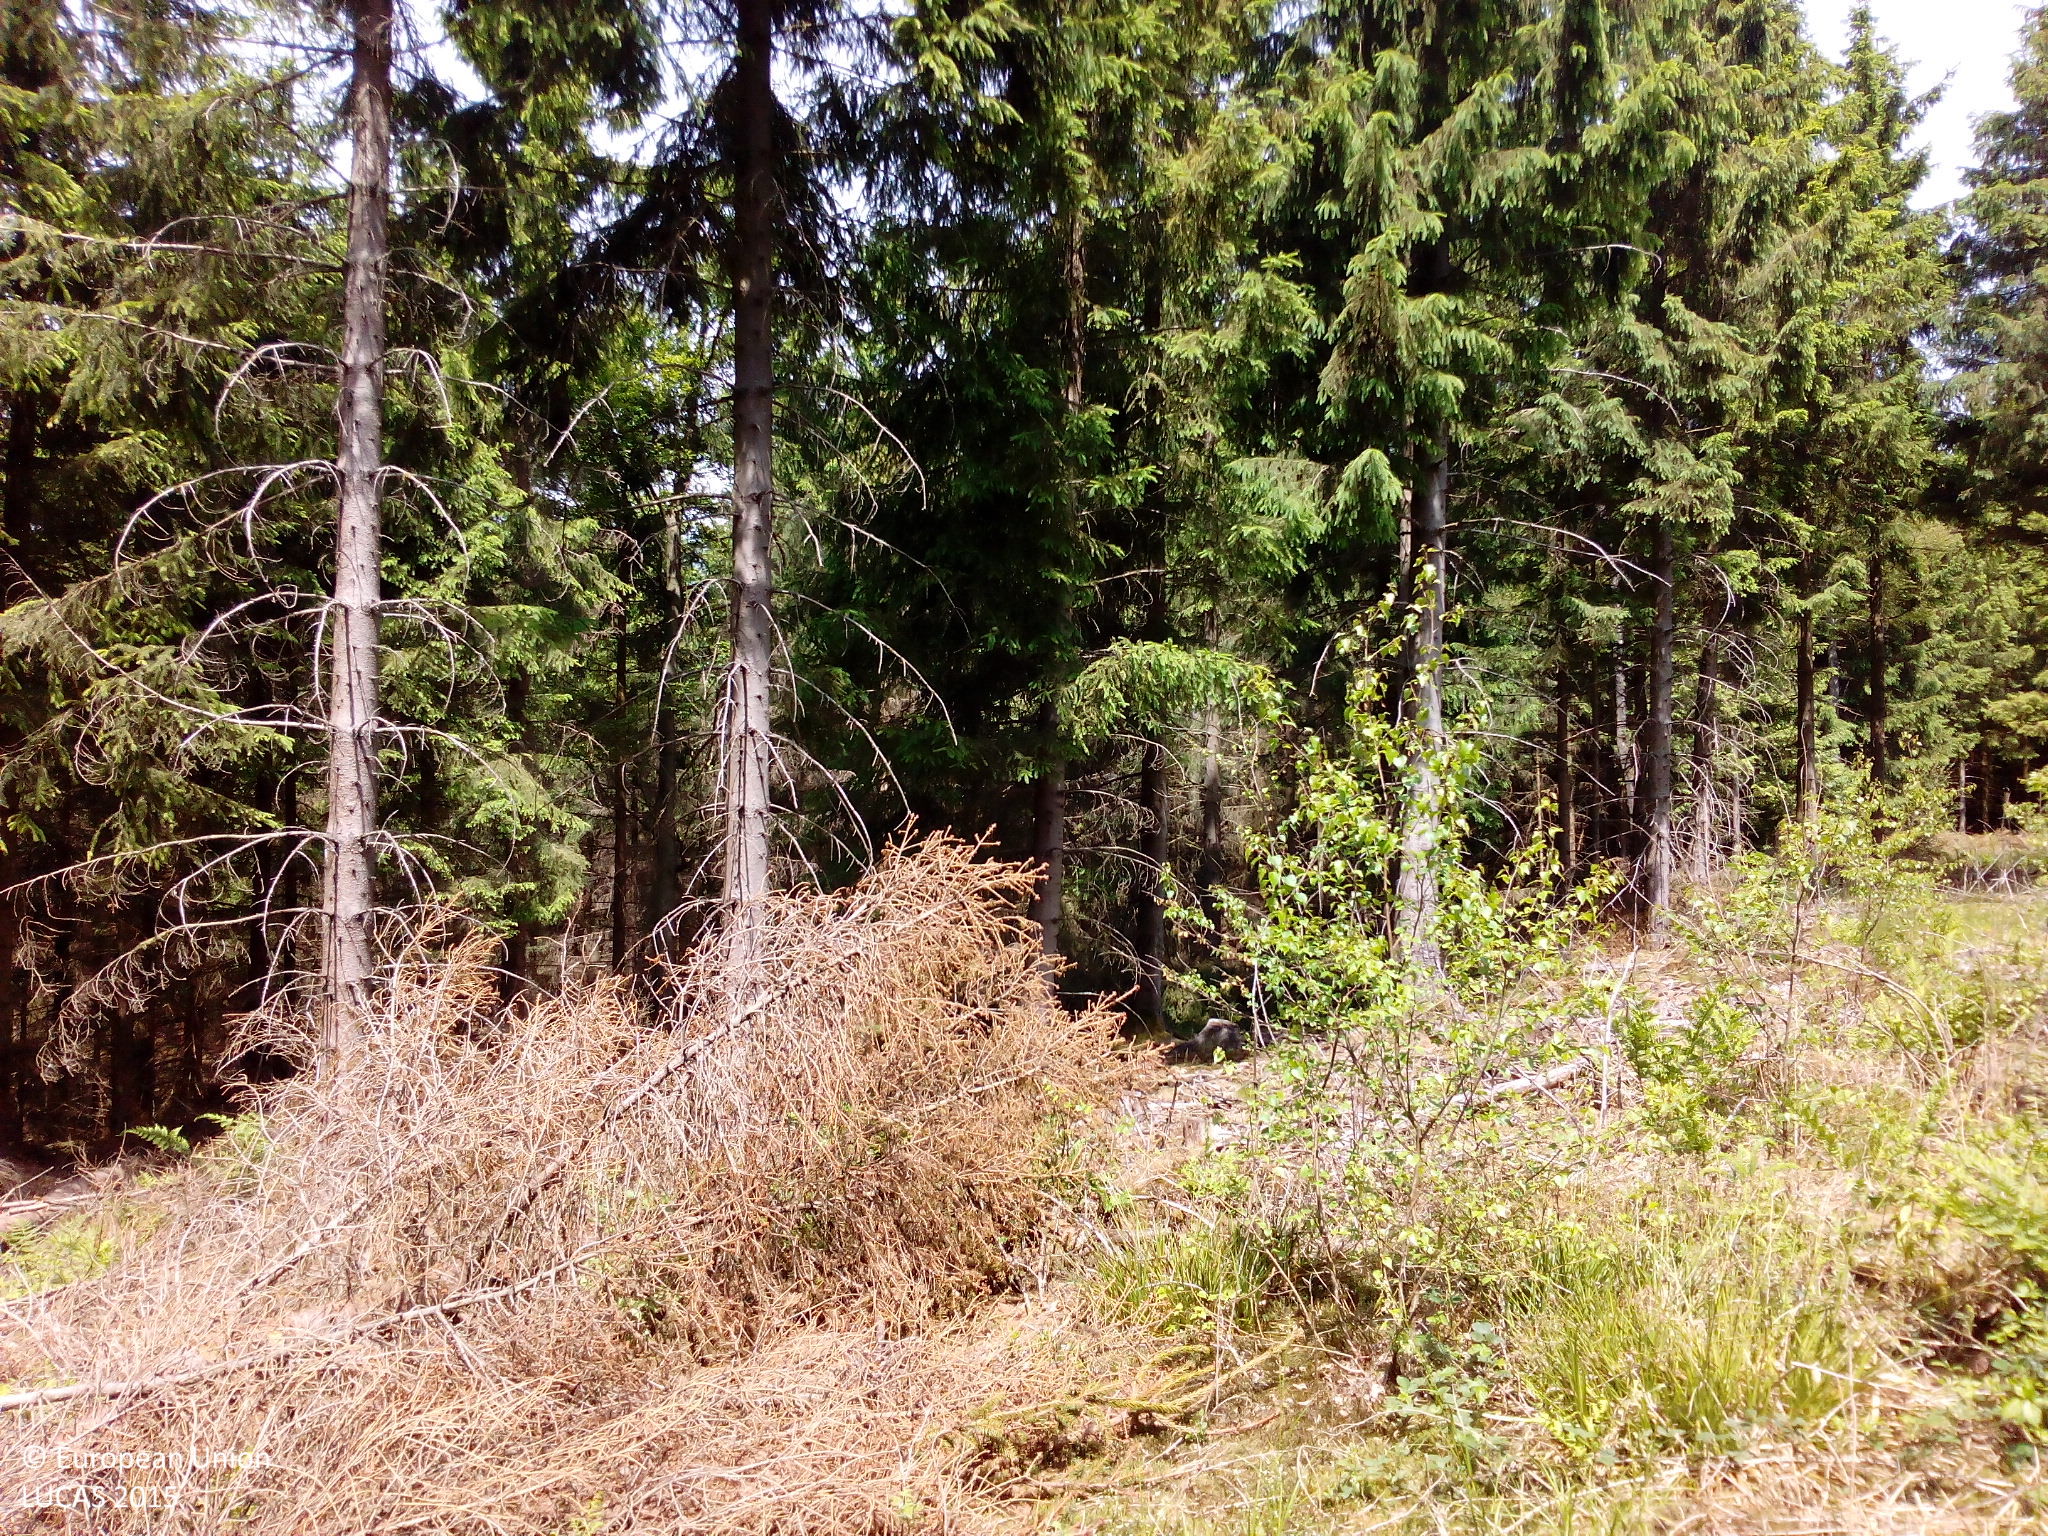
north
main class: Woodland
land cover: Spruce dominated mixed woodland
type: hemiboreal forest and nemoral coniferous forest and mixed broadleaved-coniferous forest
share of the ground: 50 - 75 %
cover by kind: coniferous forest trees 40 %, broadleaved forest trees 25 %, herbaceous plants 20 %, shrubs 15 %
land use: Forestry
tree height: > 5 m
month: June
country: DE
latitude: 51.3967
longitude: 8.4625
